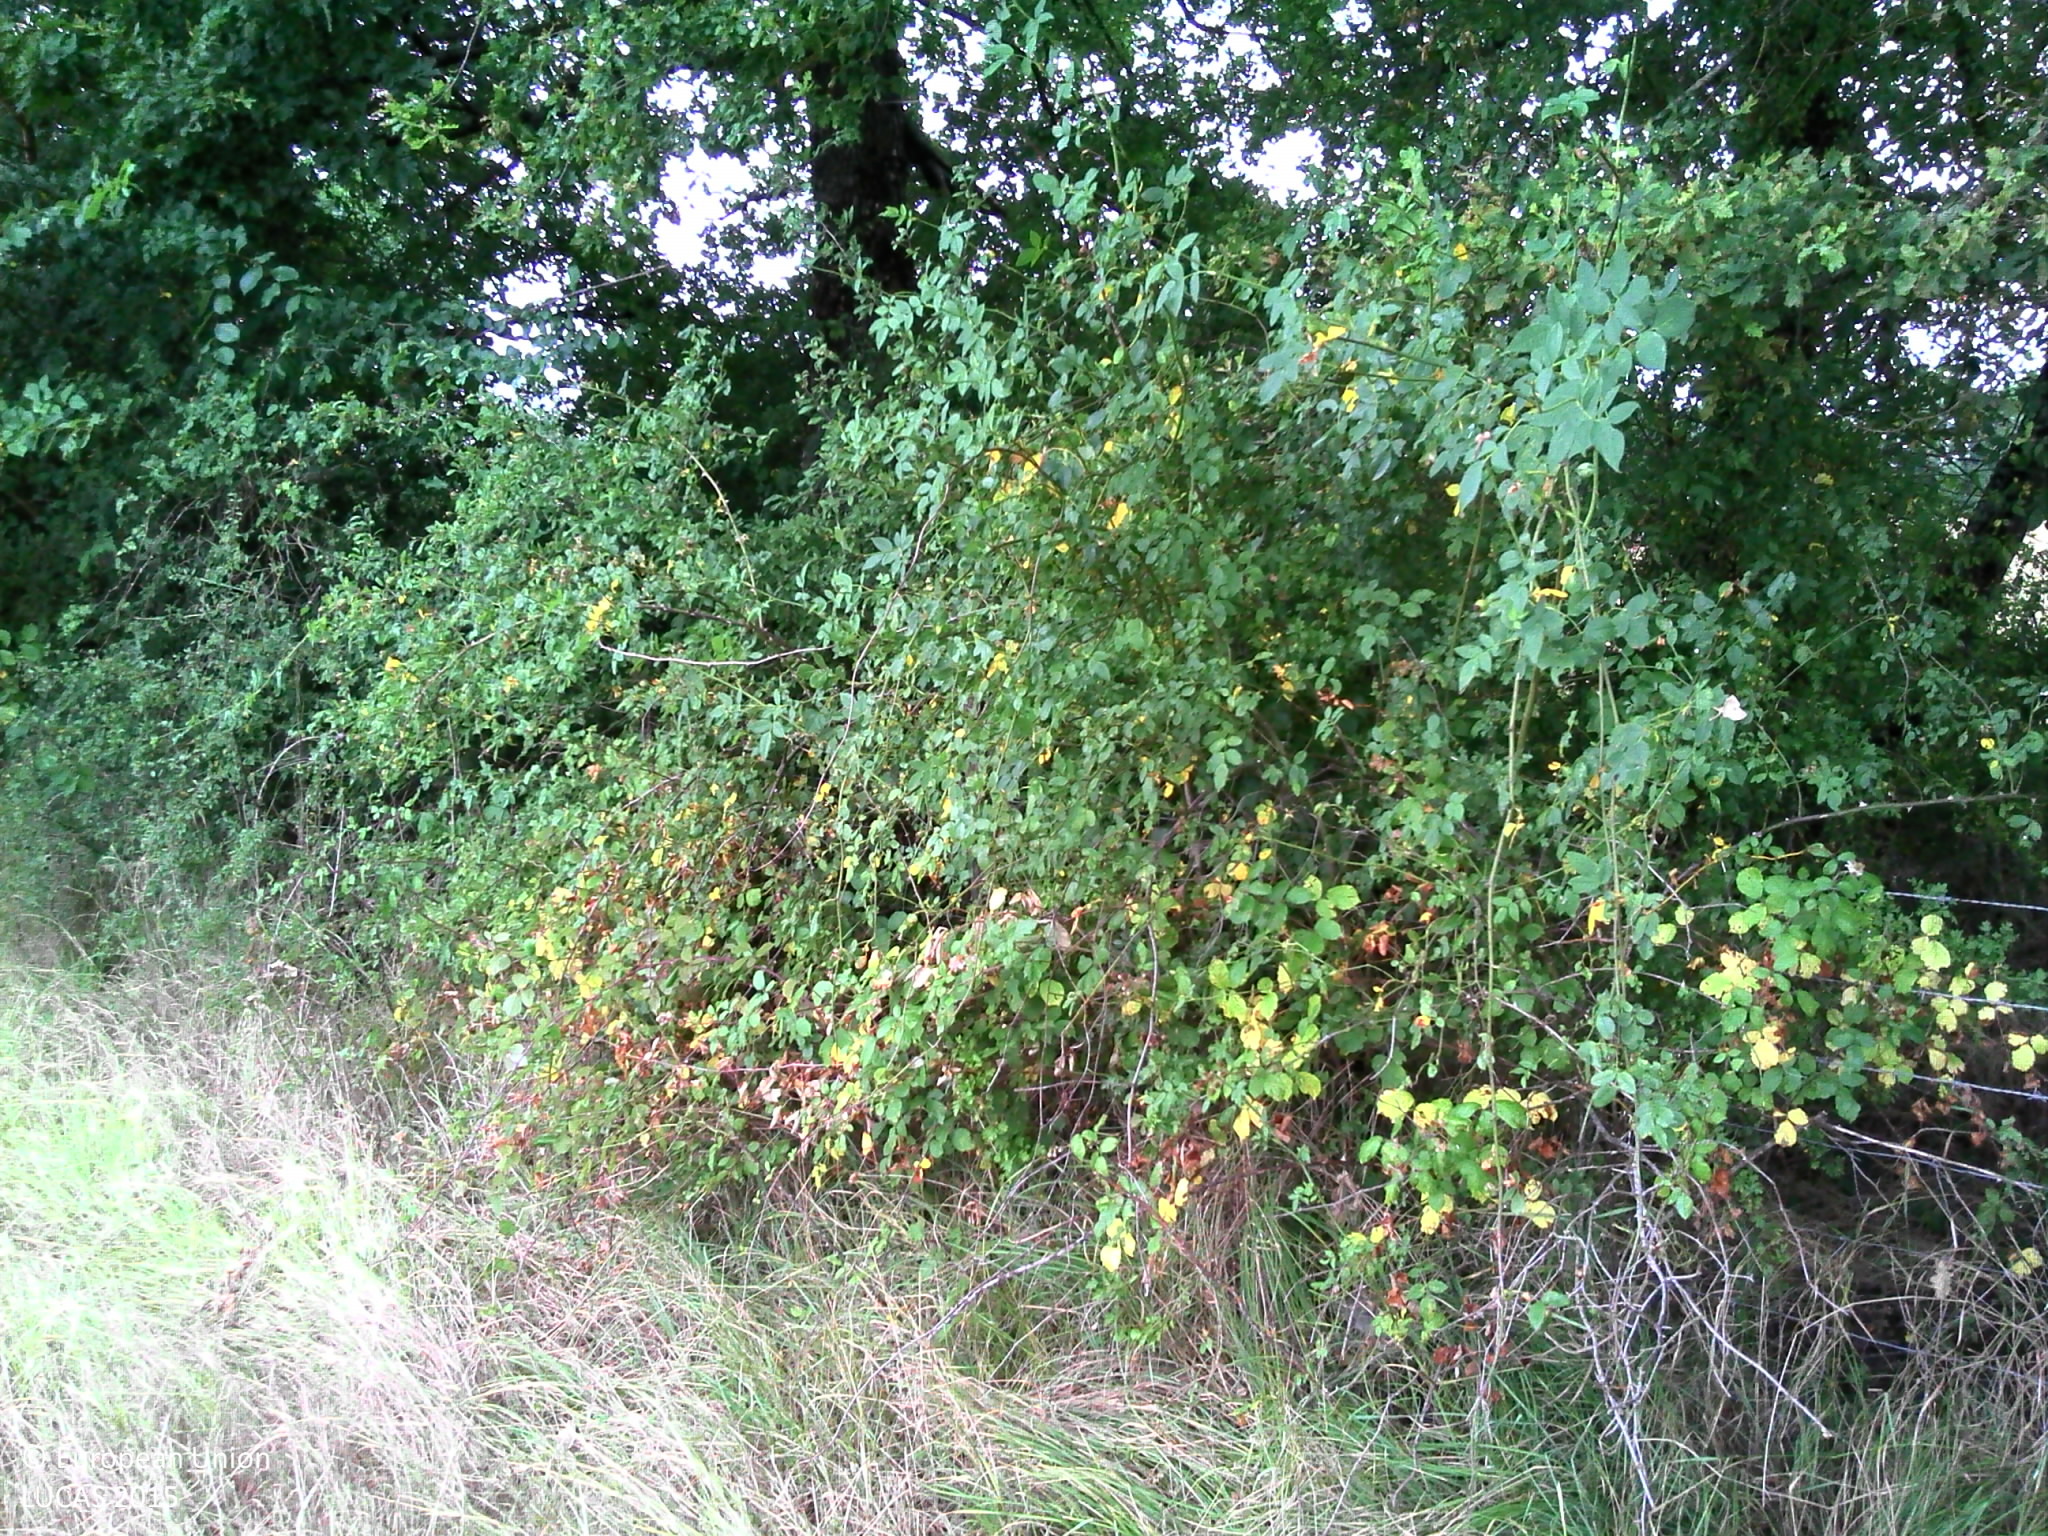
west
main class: Grassland
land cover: Grassland without tree/shrub cover
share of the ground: > 75 %
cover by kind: herbaceous plants 100 %
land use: Agriculture (excluding fallow land and kitchen gardens)
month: July
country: FR
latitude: 46.3322
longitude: 0.5658
